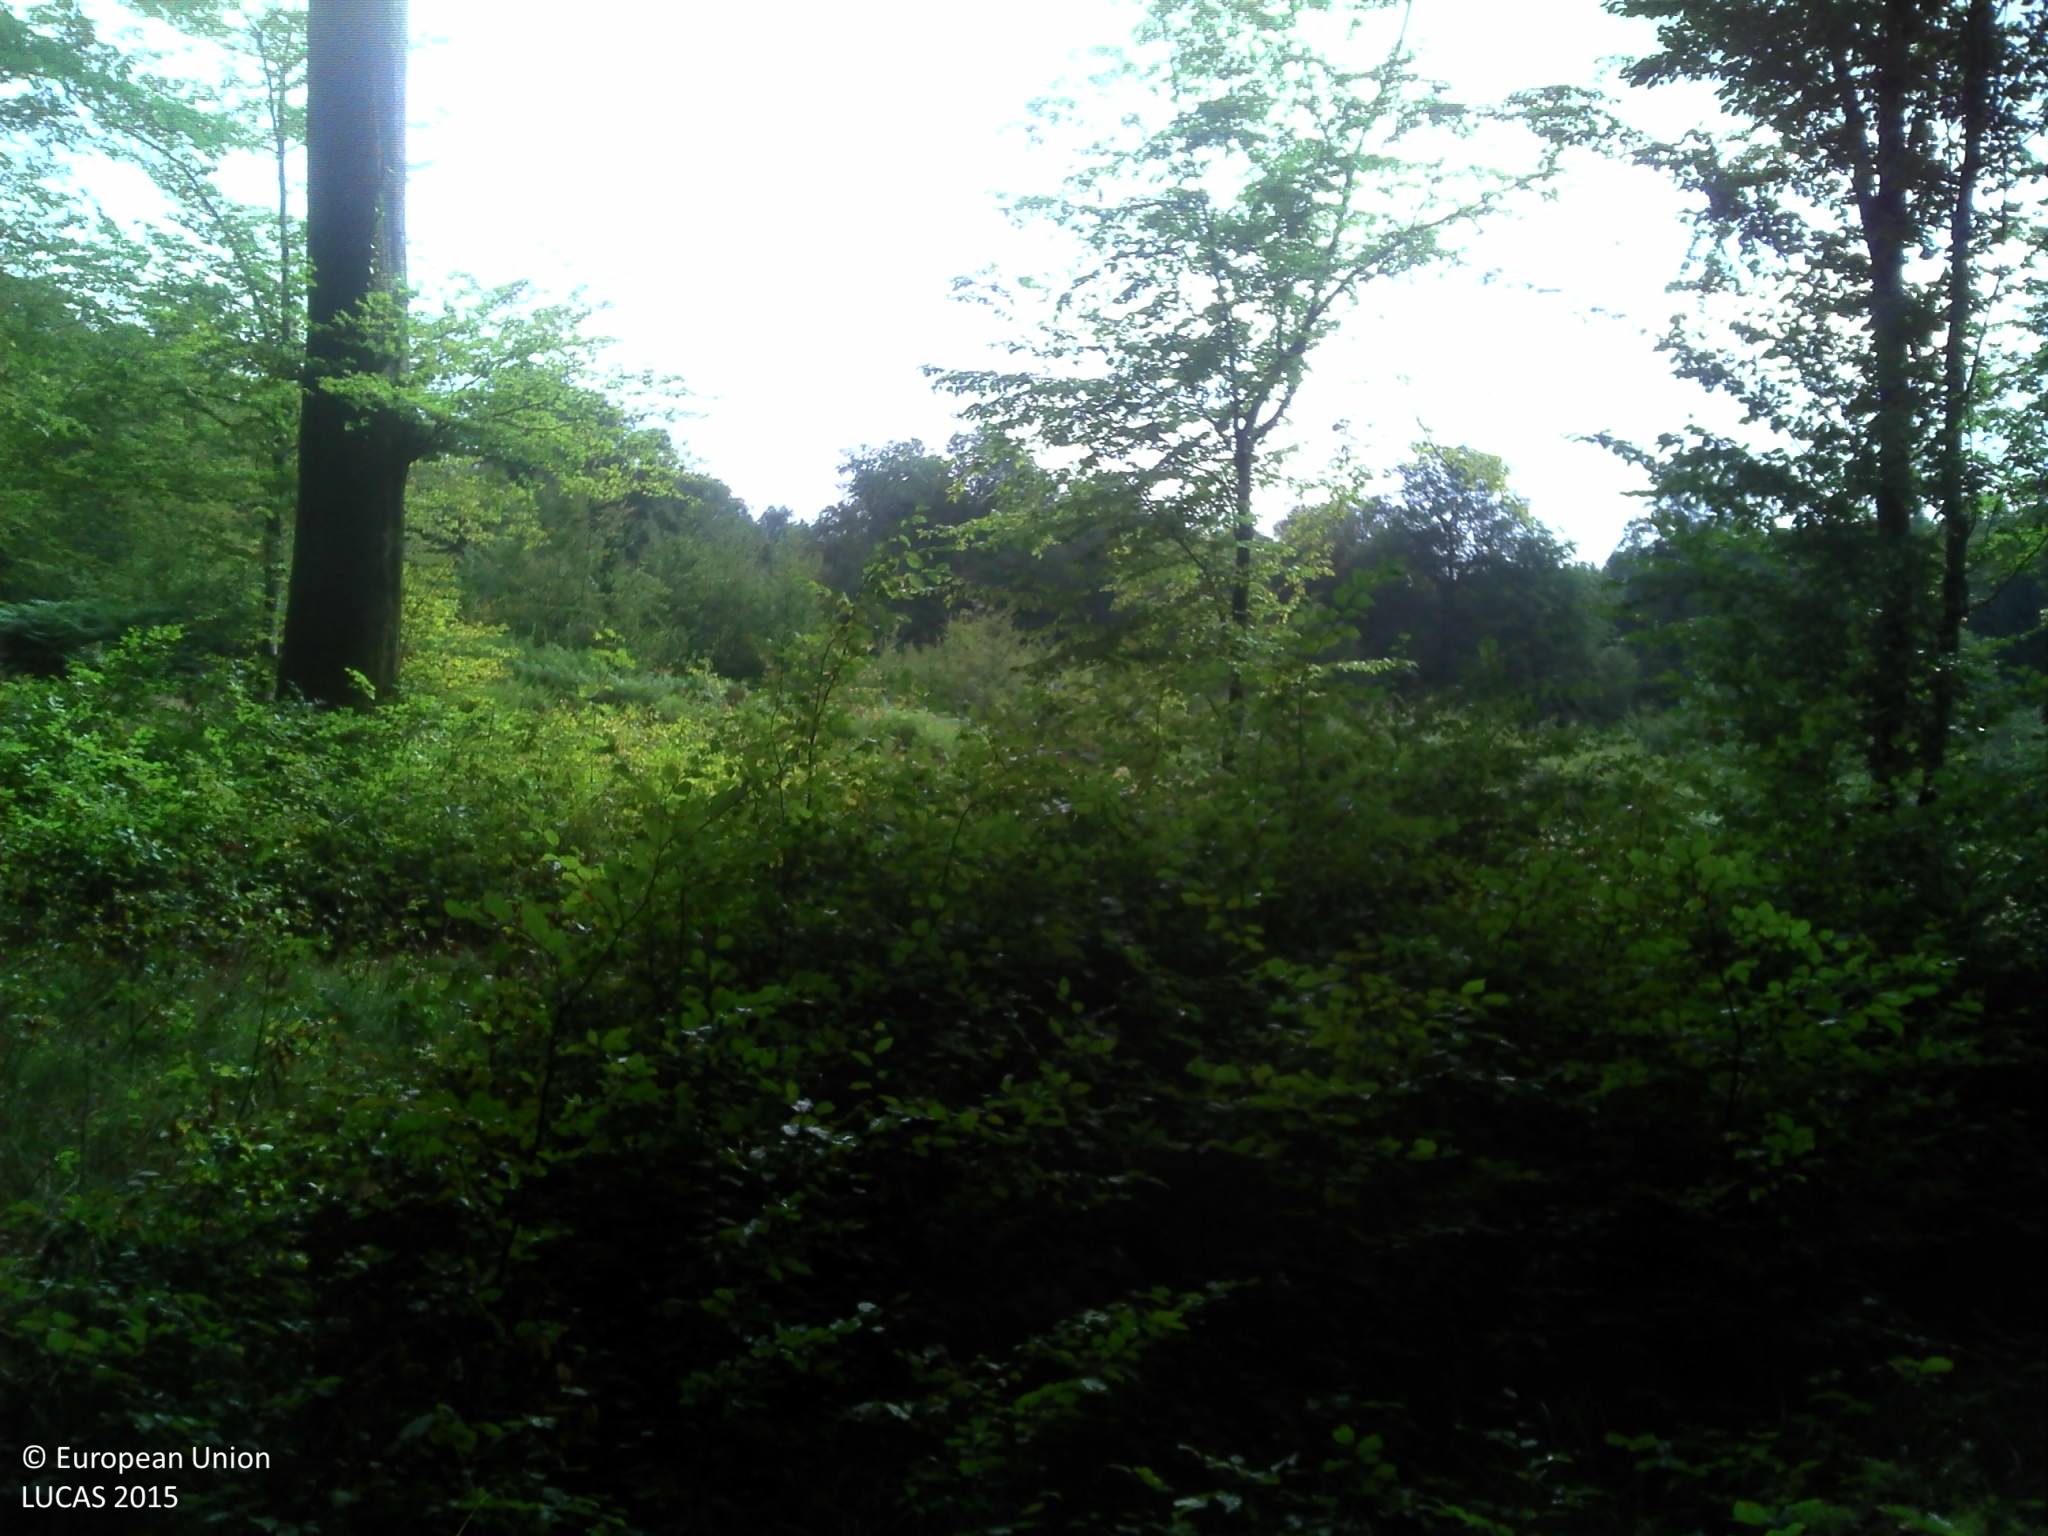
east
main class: Woodland
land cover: Broadleaved woodland
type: mesophytic deciduous forest
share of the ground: > 75 %
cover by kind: broadleaved forest trees 90 %, herbaceous plants 10 %
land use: Forestry
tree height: > 5 m
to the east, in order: Broadleaved woodland; Tracks; Broadleaved woodland; Tracks; Spontaneously vegetated surfaces; Broadleaved woodland; Tracks; Broadleaved woodland
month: September
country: FR
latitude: 47.4951
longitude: 6.8823
